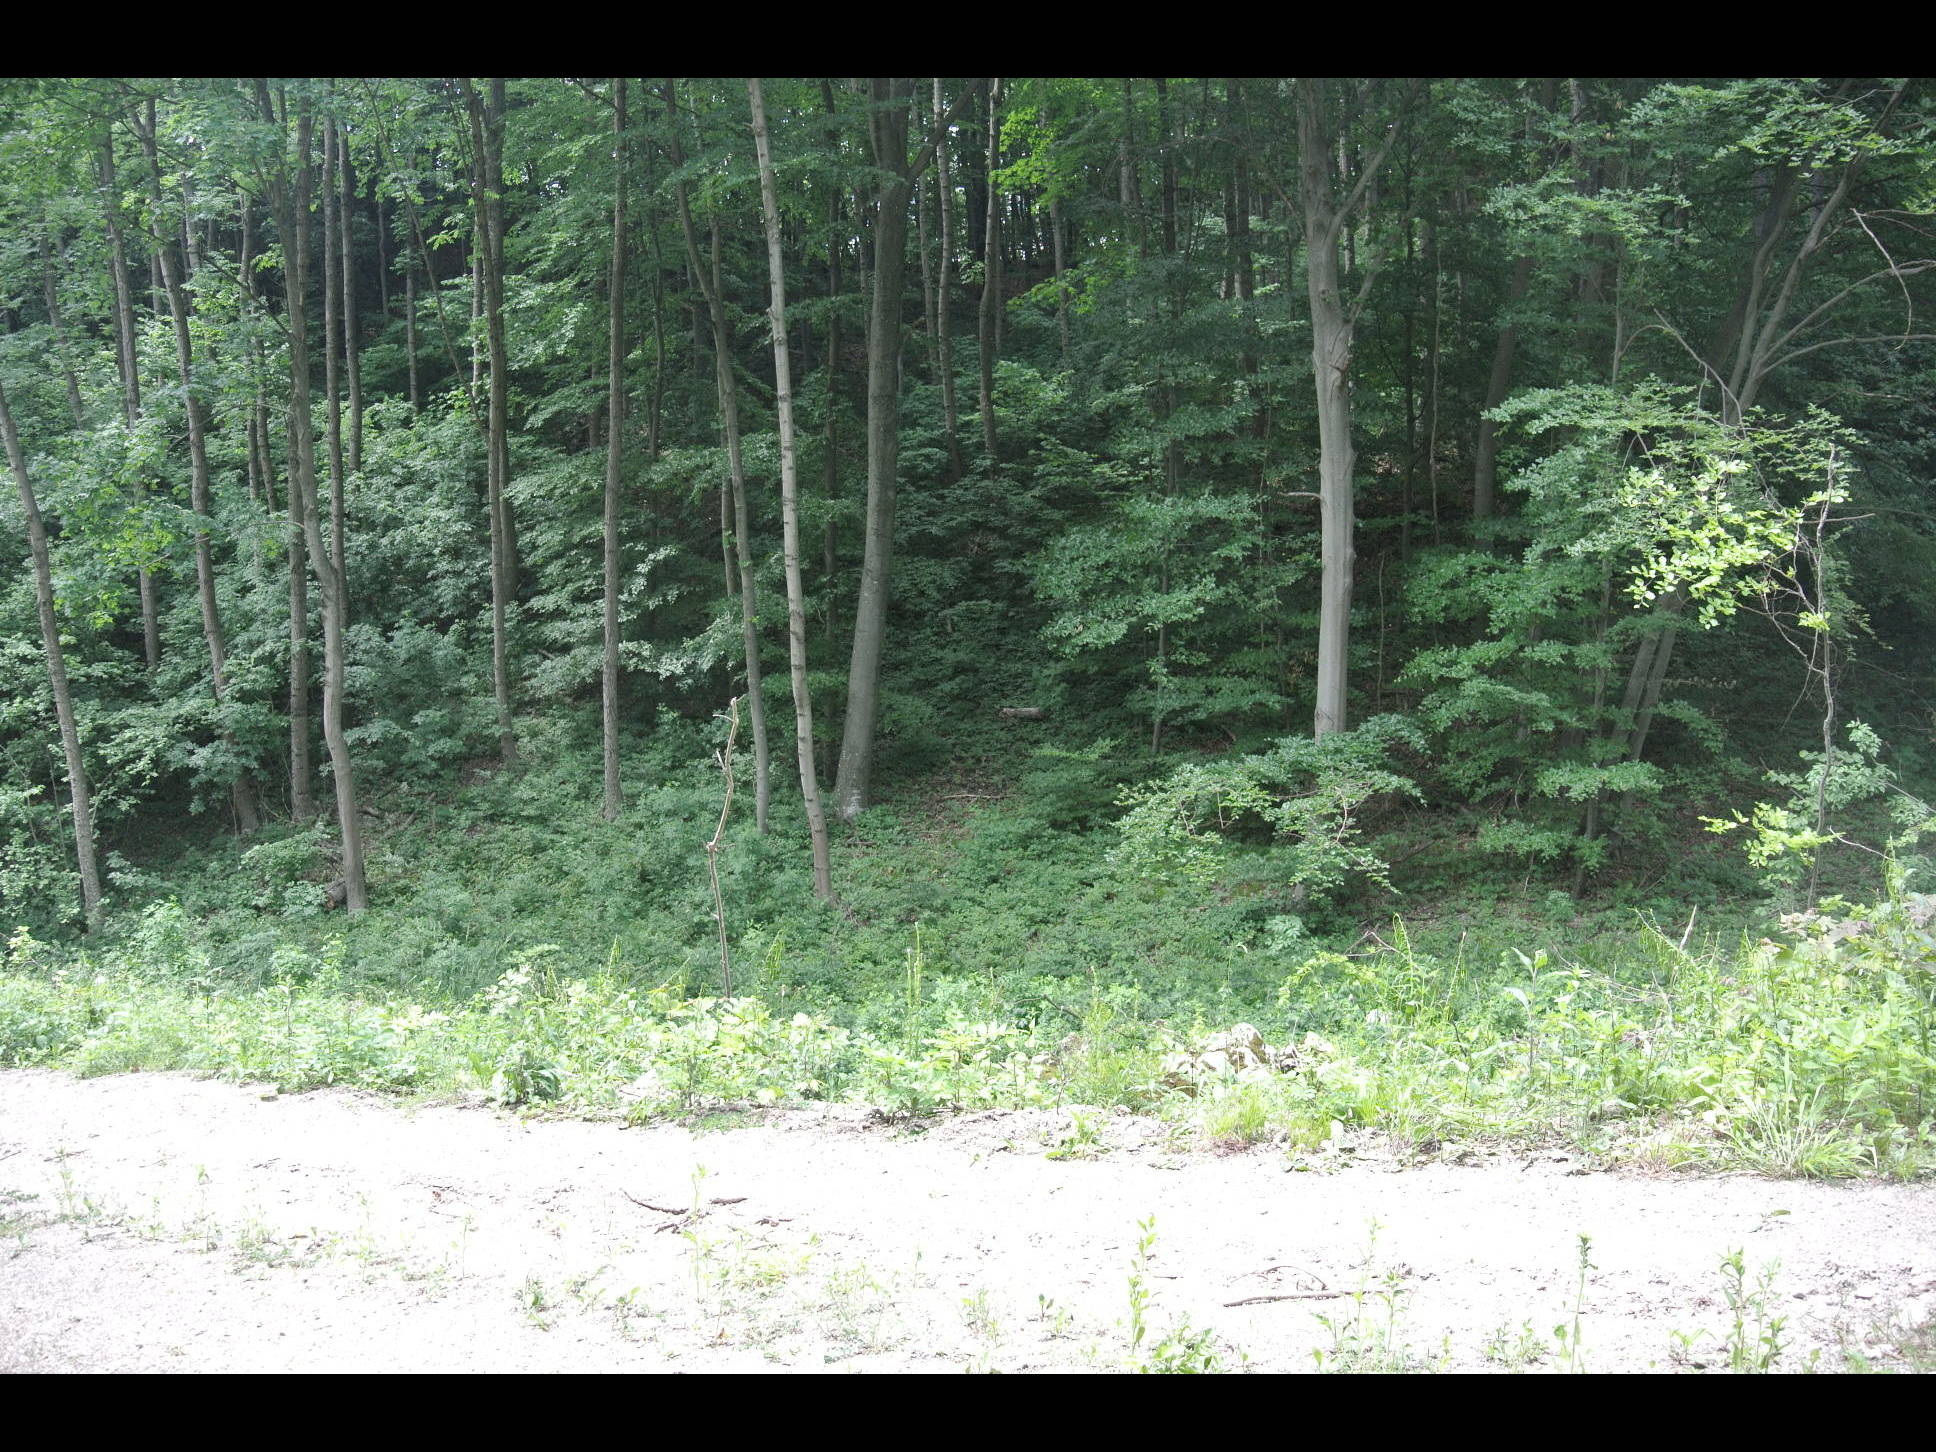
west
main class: Grassland
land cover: Spontaneously vegetated surfaces
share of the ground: > 75 %
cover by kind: herbaceous plants 95 %, shrubs 5 %
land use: Forestry
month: June
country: AT
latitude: 48.0004
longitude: 16.1019
